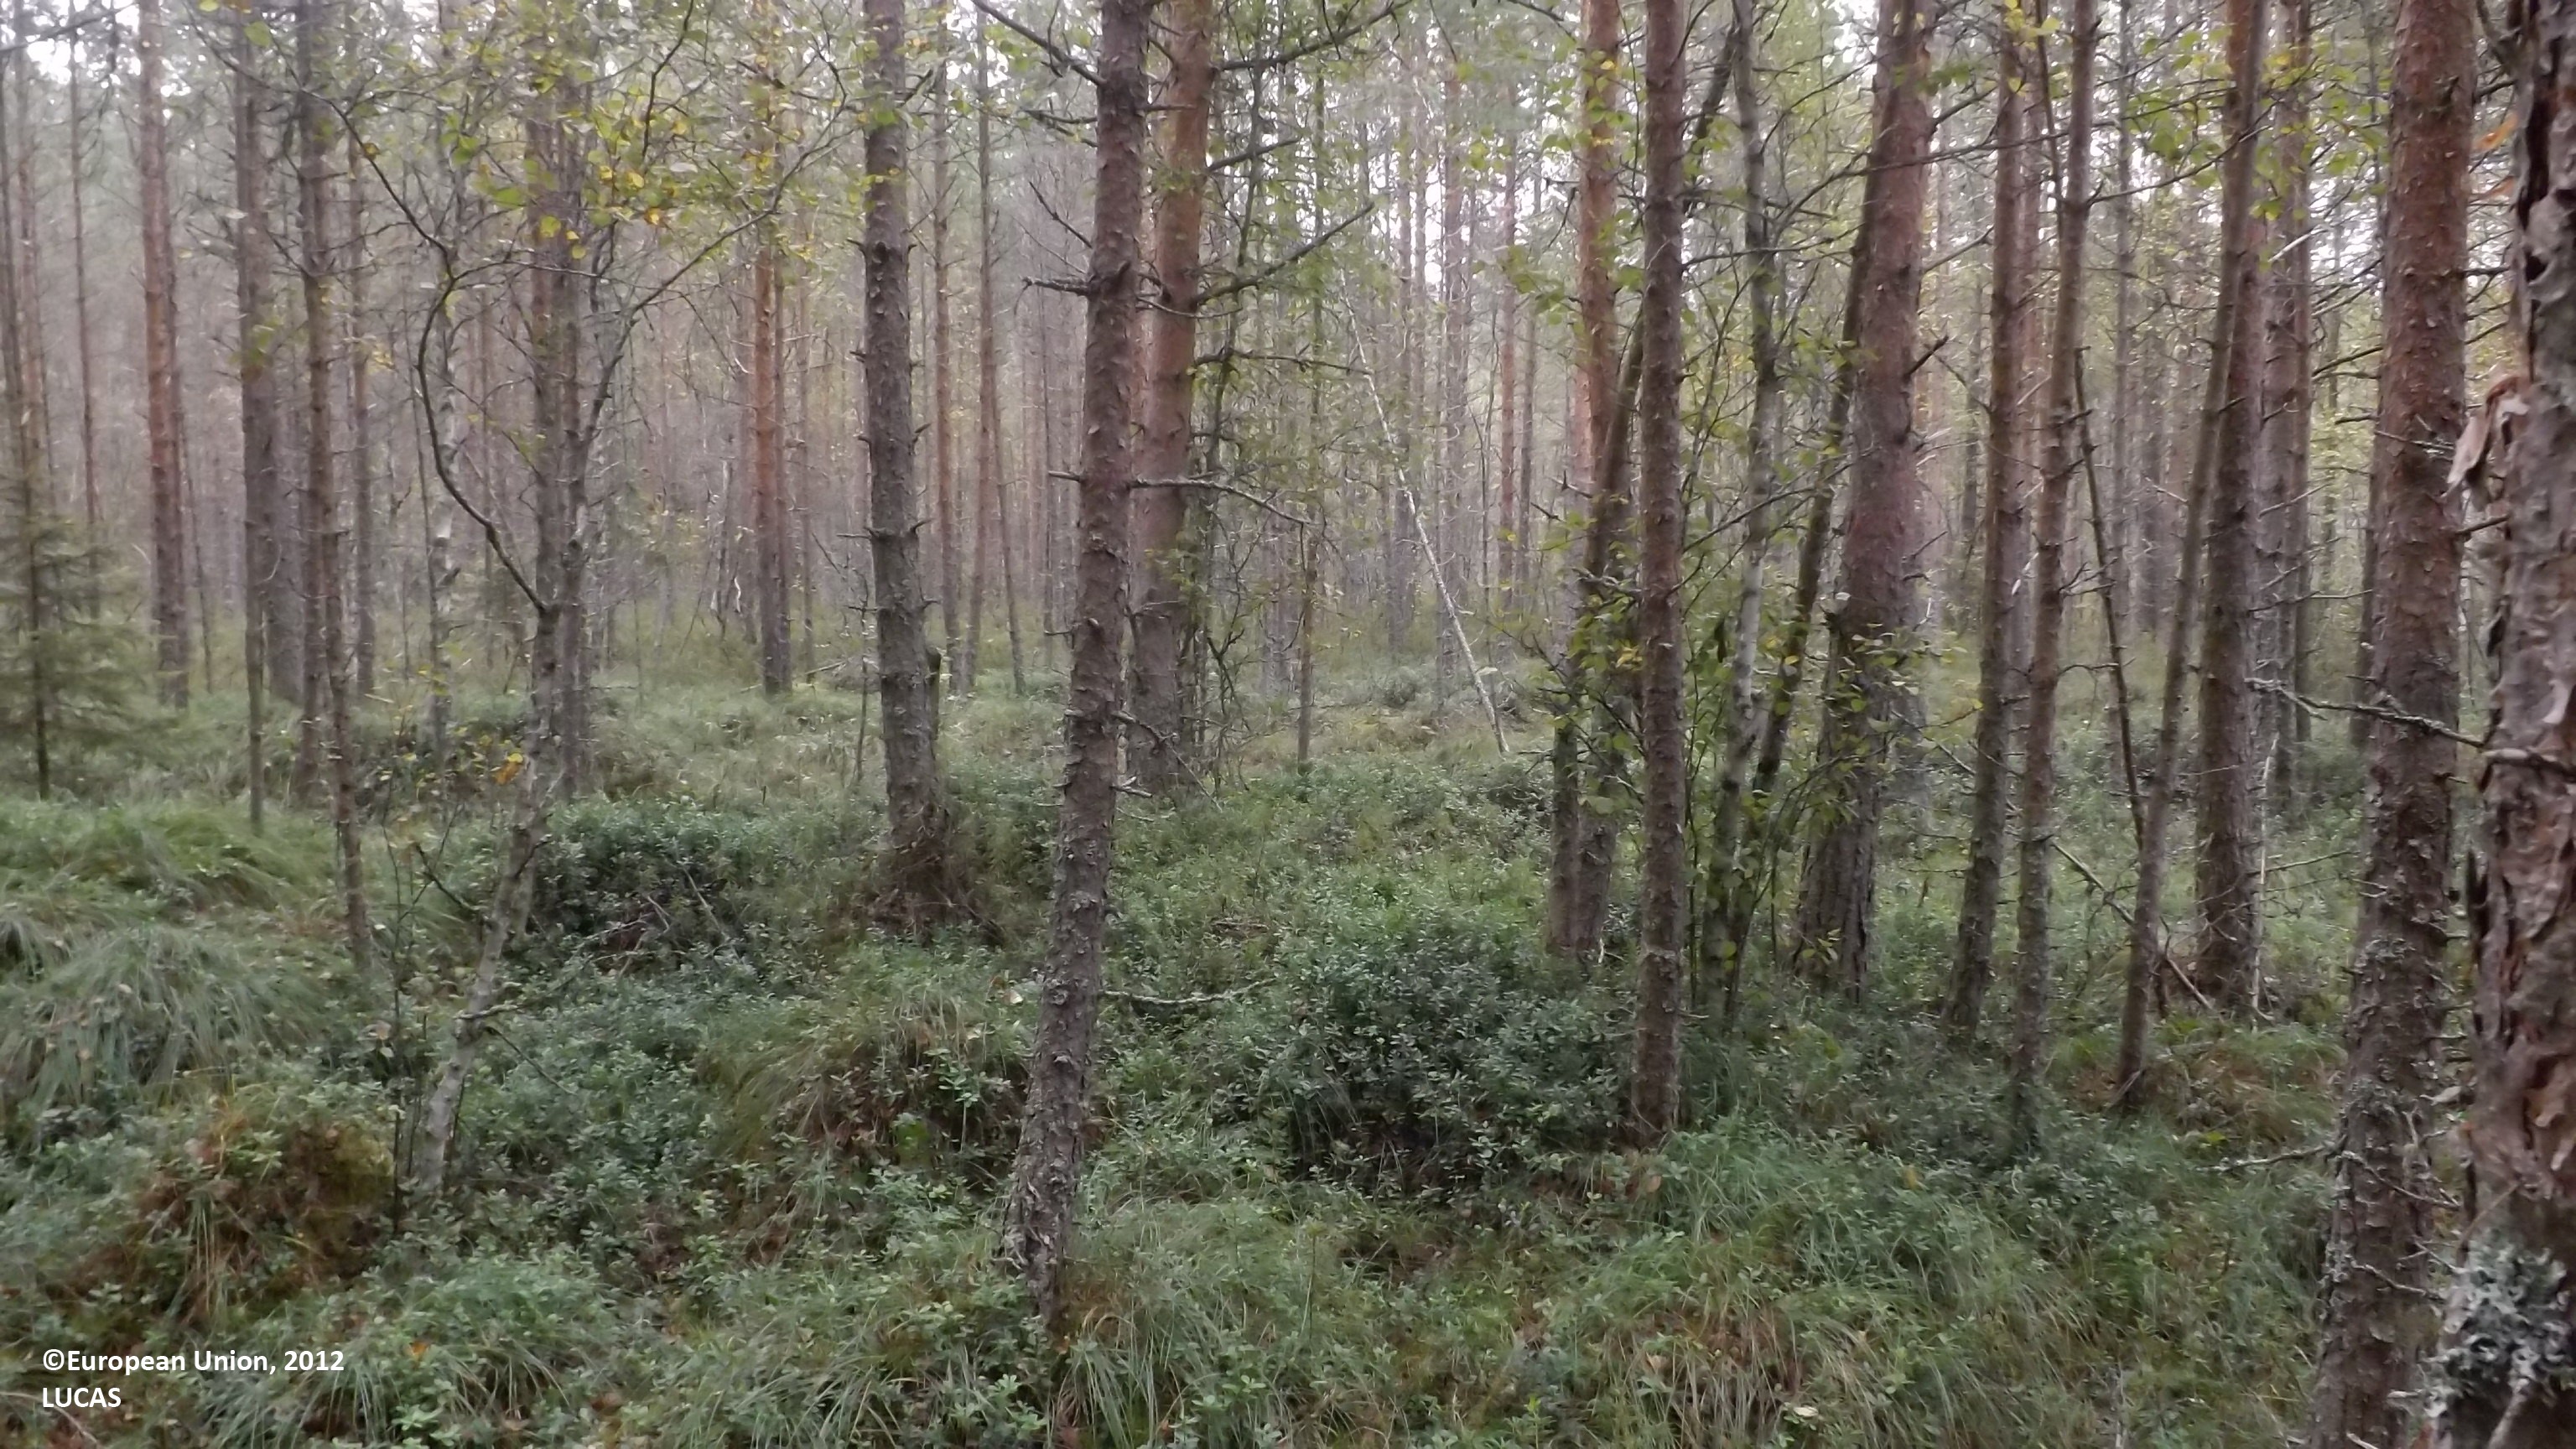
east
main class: Woodland
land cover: Pine dominated mixed woodland
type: boreal forest
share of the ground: > 75 %
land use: Forestry
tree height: > 5 m
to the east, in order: Pine dominated mixed woodland; Ditches and canals; Pine dominated mixed woodland; Pine dominated coniferous woodland; Pine dominated mixed woodland; Other mixed woodland; Ditches and canals; Other mixed woodland
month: August
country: FI
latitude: 63.8299
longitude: 23.5743
